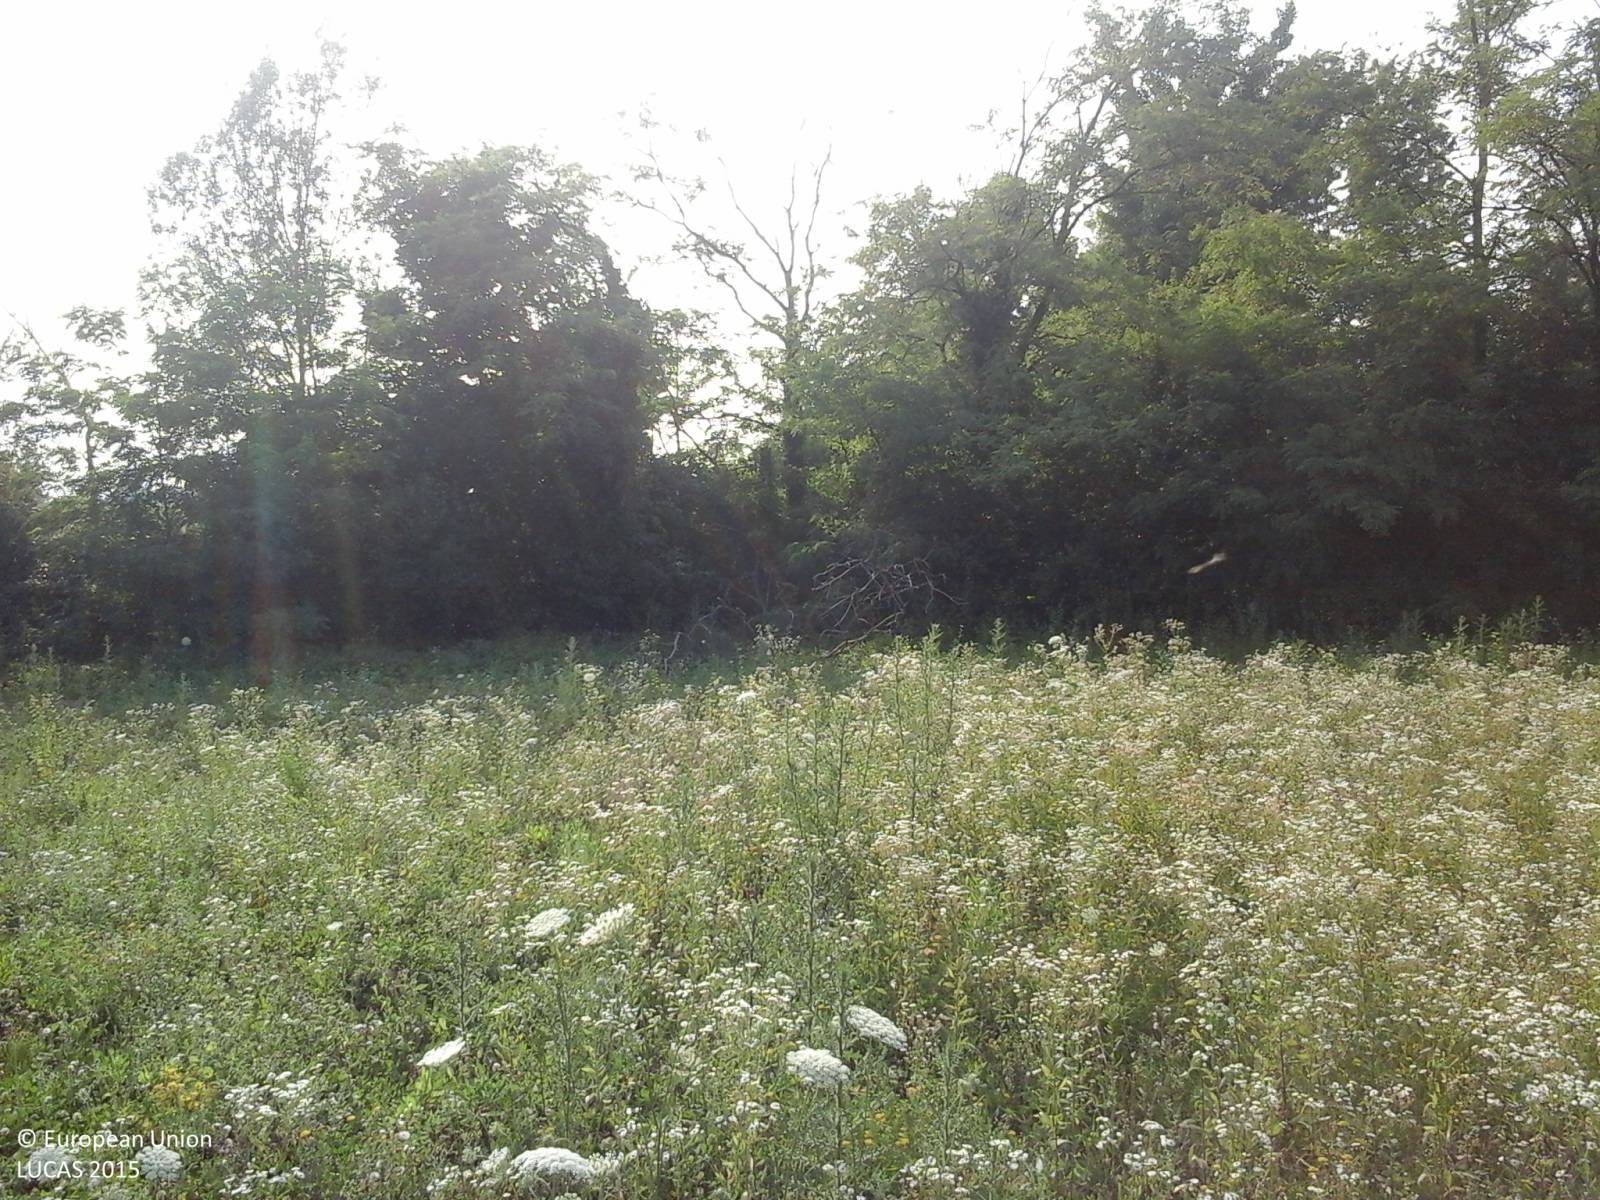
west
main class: Grassland
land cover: Spontaneously vegetated surfaces
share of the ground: > 75 %
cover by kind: herbaceous plants 100 %
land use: Fallow land
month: July
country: IT
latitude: 45.9022
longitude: 12.7162
